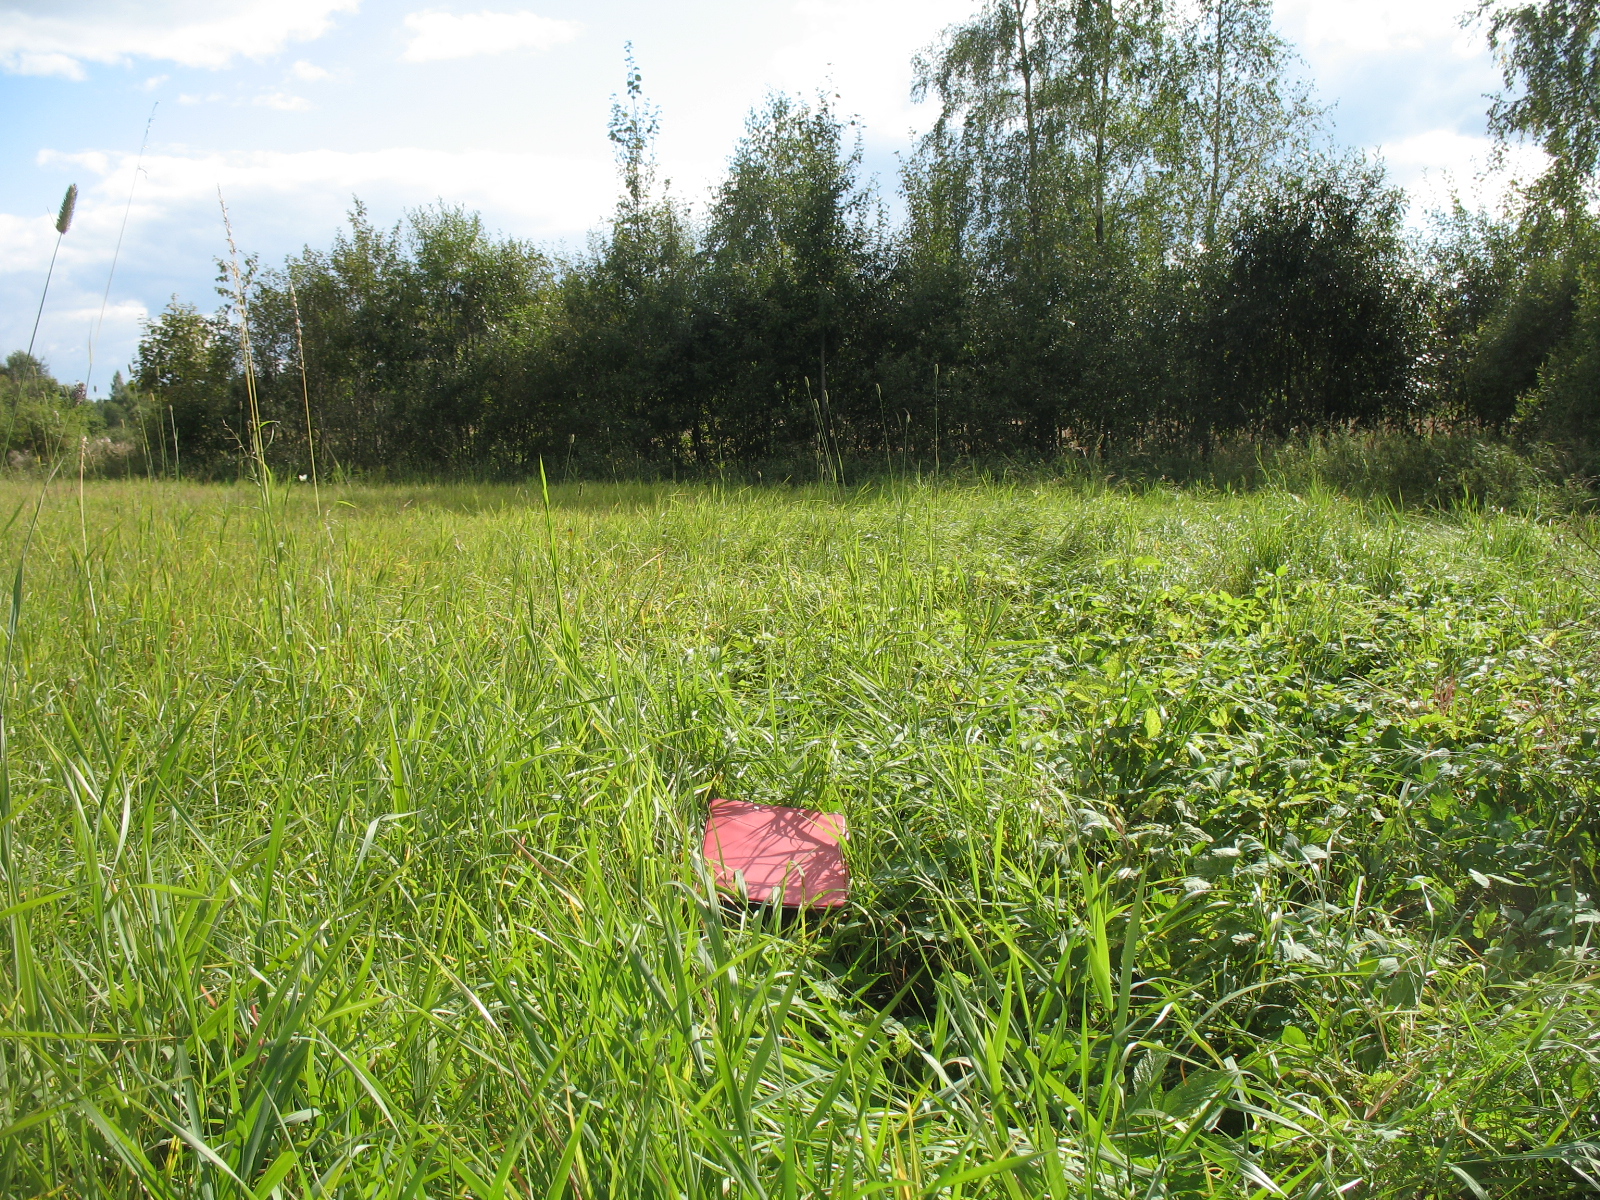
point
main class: Grassland
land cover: Grassland without tree/shrub cover
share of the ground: > 75 %
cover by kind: herbaceous plants 100 %
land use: Agriculture (excluding fallow land and kitchen gardens)
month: September
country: LV
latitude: 56.1554
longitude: 25.4966
